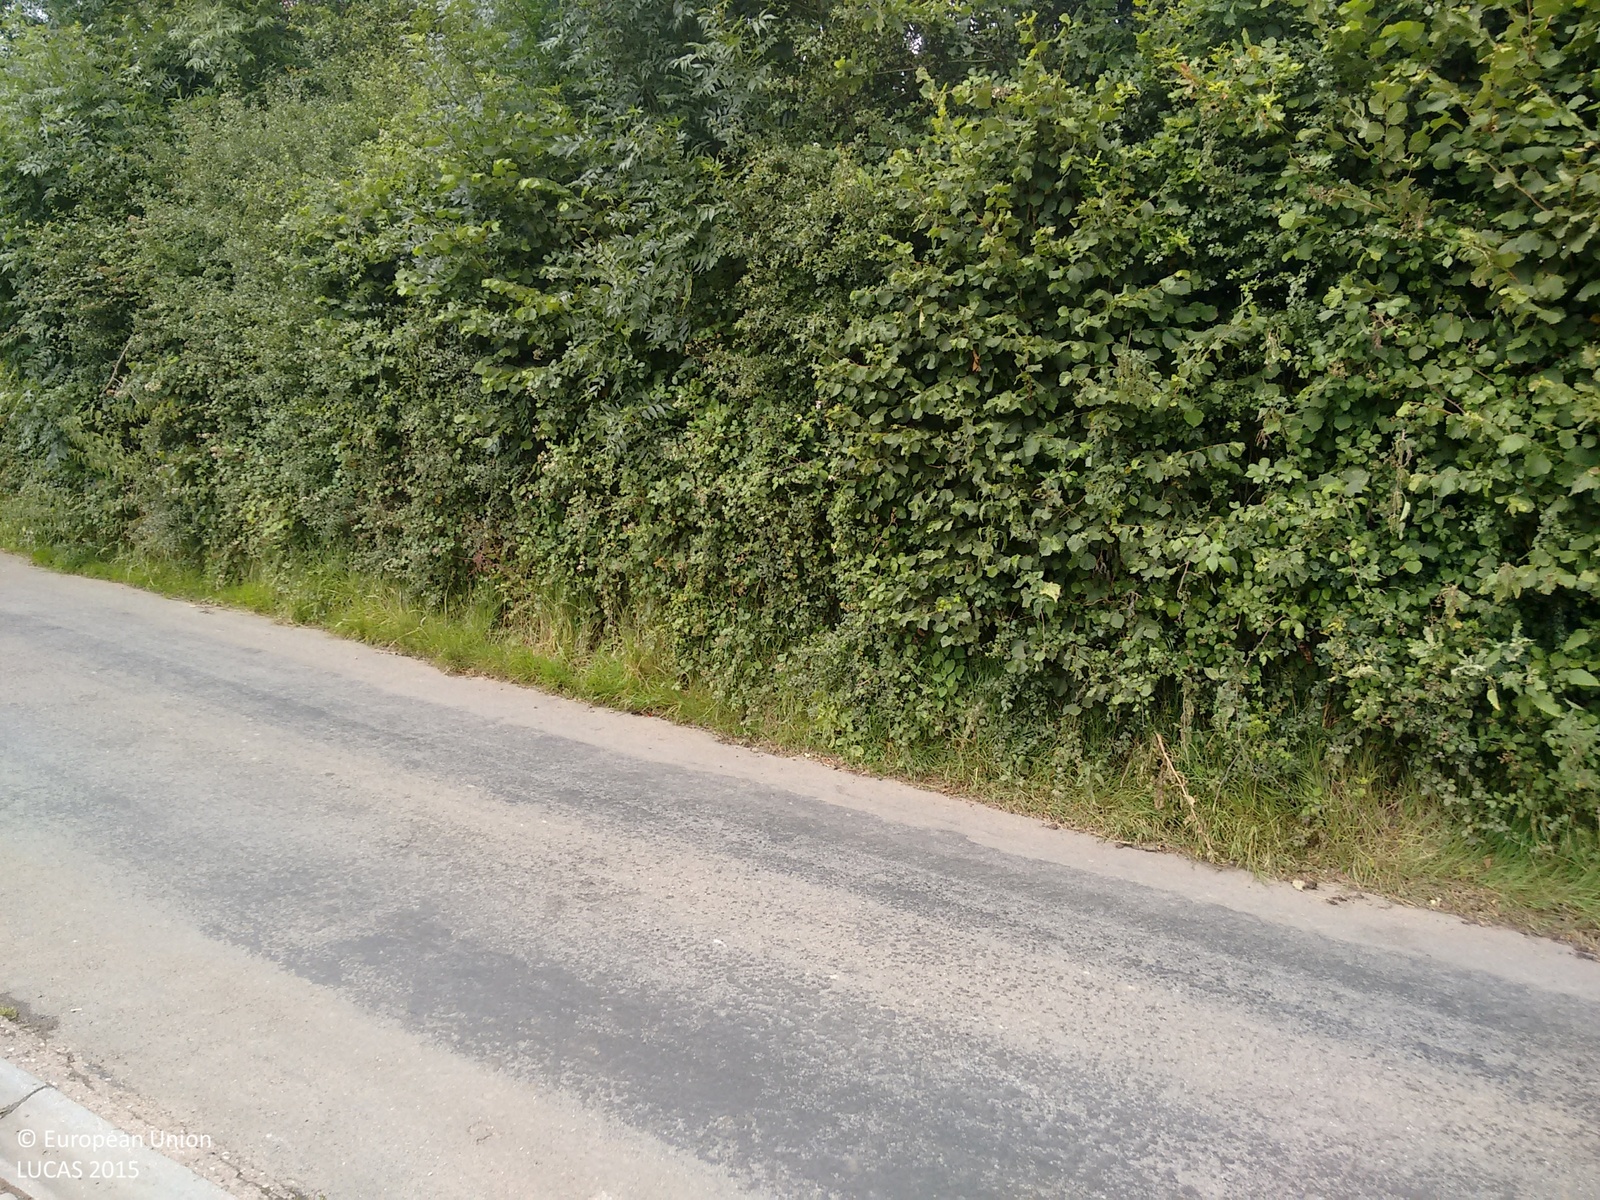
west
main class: Grassland
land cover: Grassland without tree/shrub cover
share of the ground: > 75 %
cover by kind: herbaceous plants 100 %
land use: Agriculture (excluding fallow land and kitchen gardens)
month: August
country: GB
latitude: 50.7701
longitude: -3.7437
